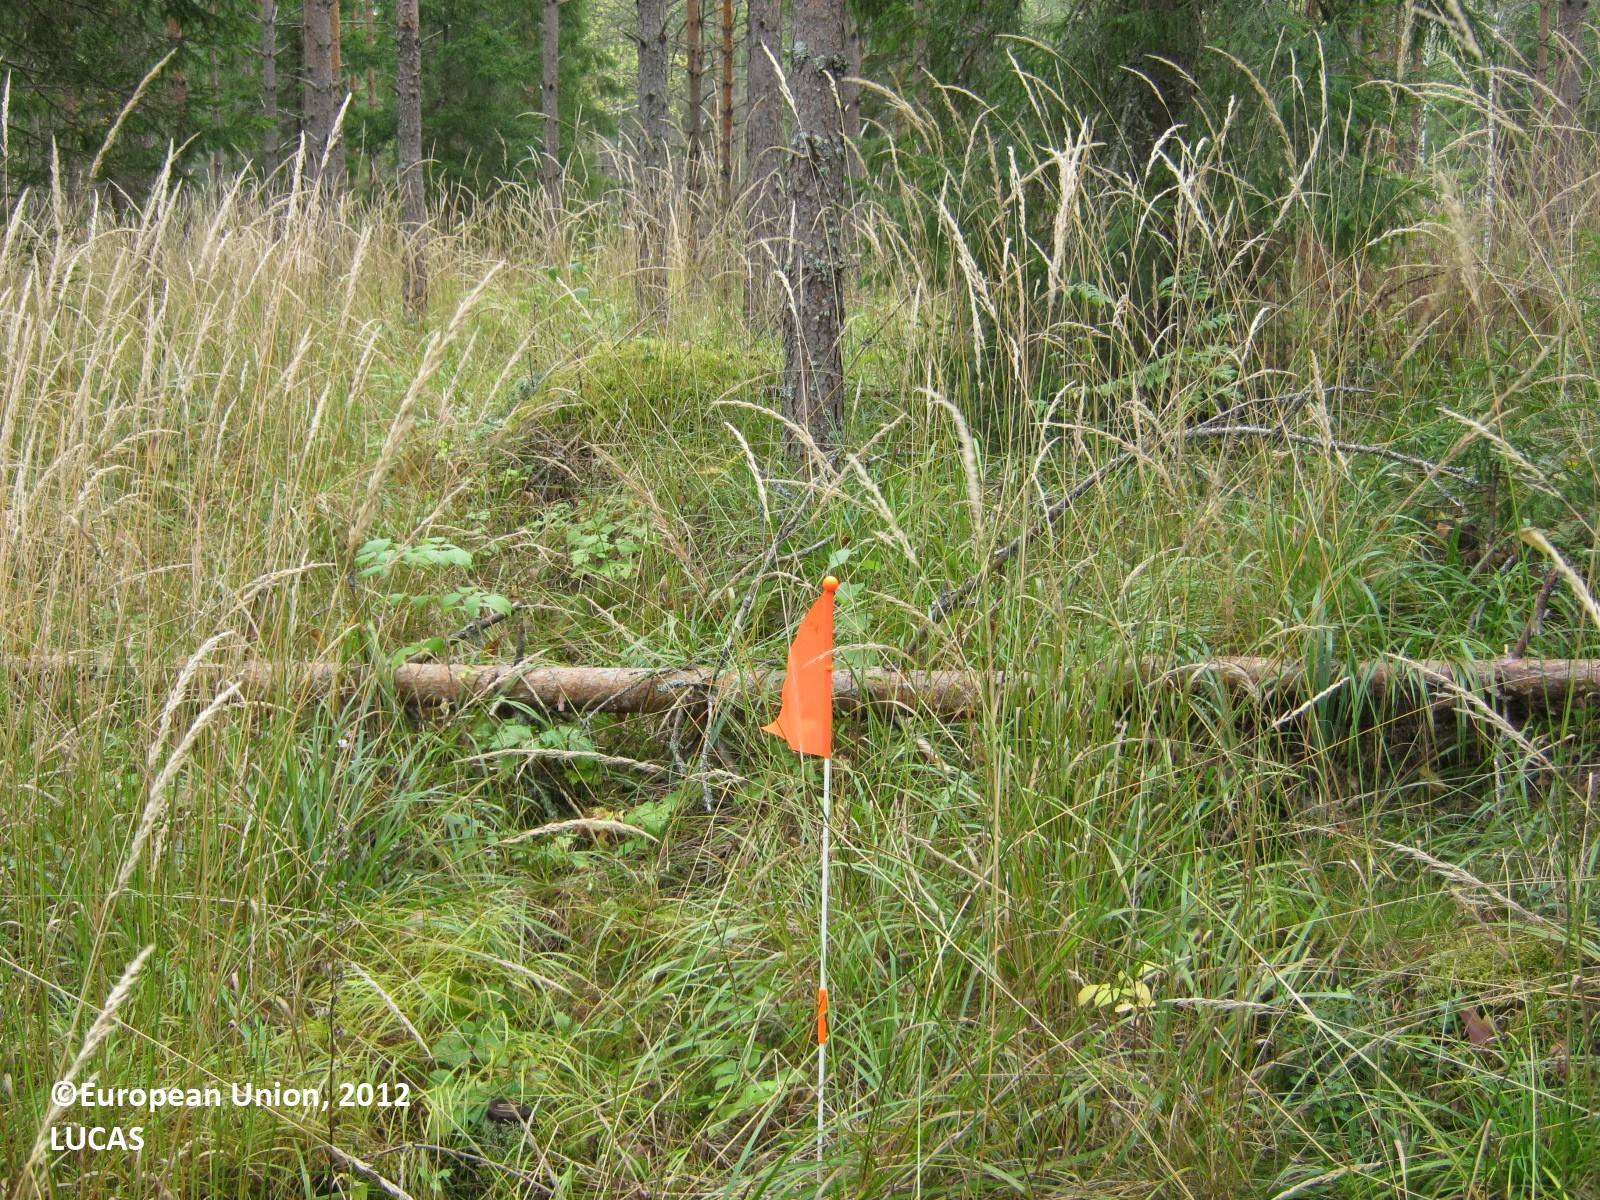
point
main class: Woodland
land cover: Pine dominated coniferous woodland
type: boreal forest
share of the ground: > 75 %
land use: Forestry
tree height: > 5 m
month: September
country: FI
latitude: 60.7371
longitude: 27.6677
